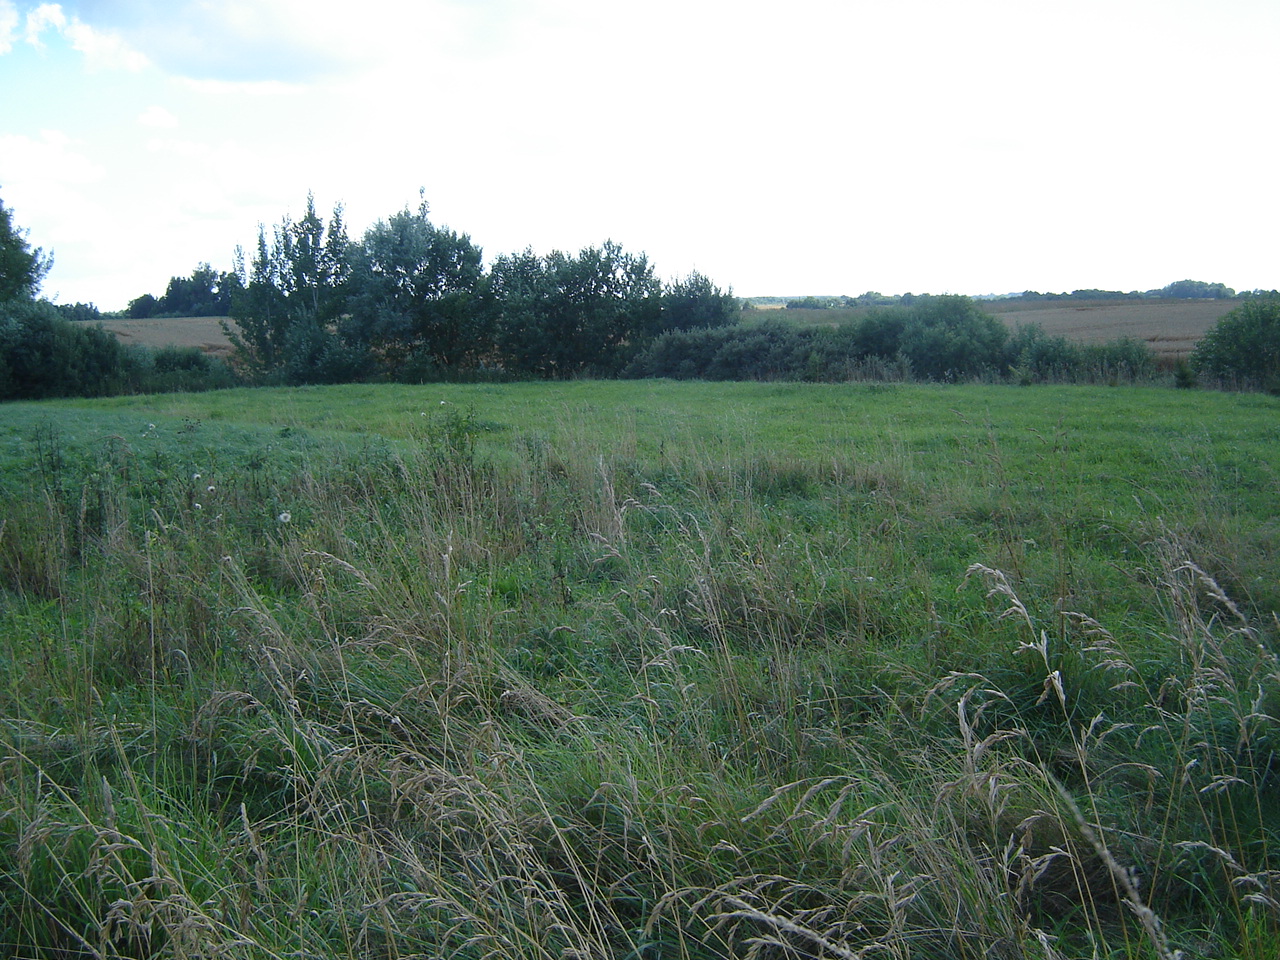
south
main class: Grassland
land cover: Spontaneously vegetated surfaces
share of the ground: > 75 %
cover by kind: herbaceous plants 95 %, shrubs 5 %
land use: Abandoned areas
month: August
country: LT
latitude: 55.0187
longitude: 24.8909
